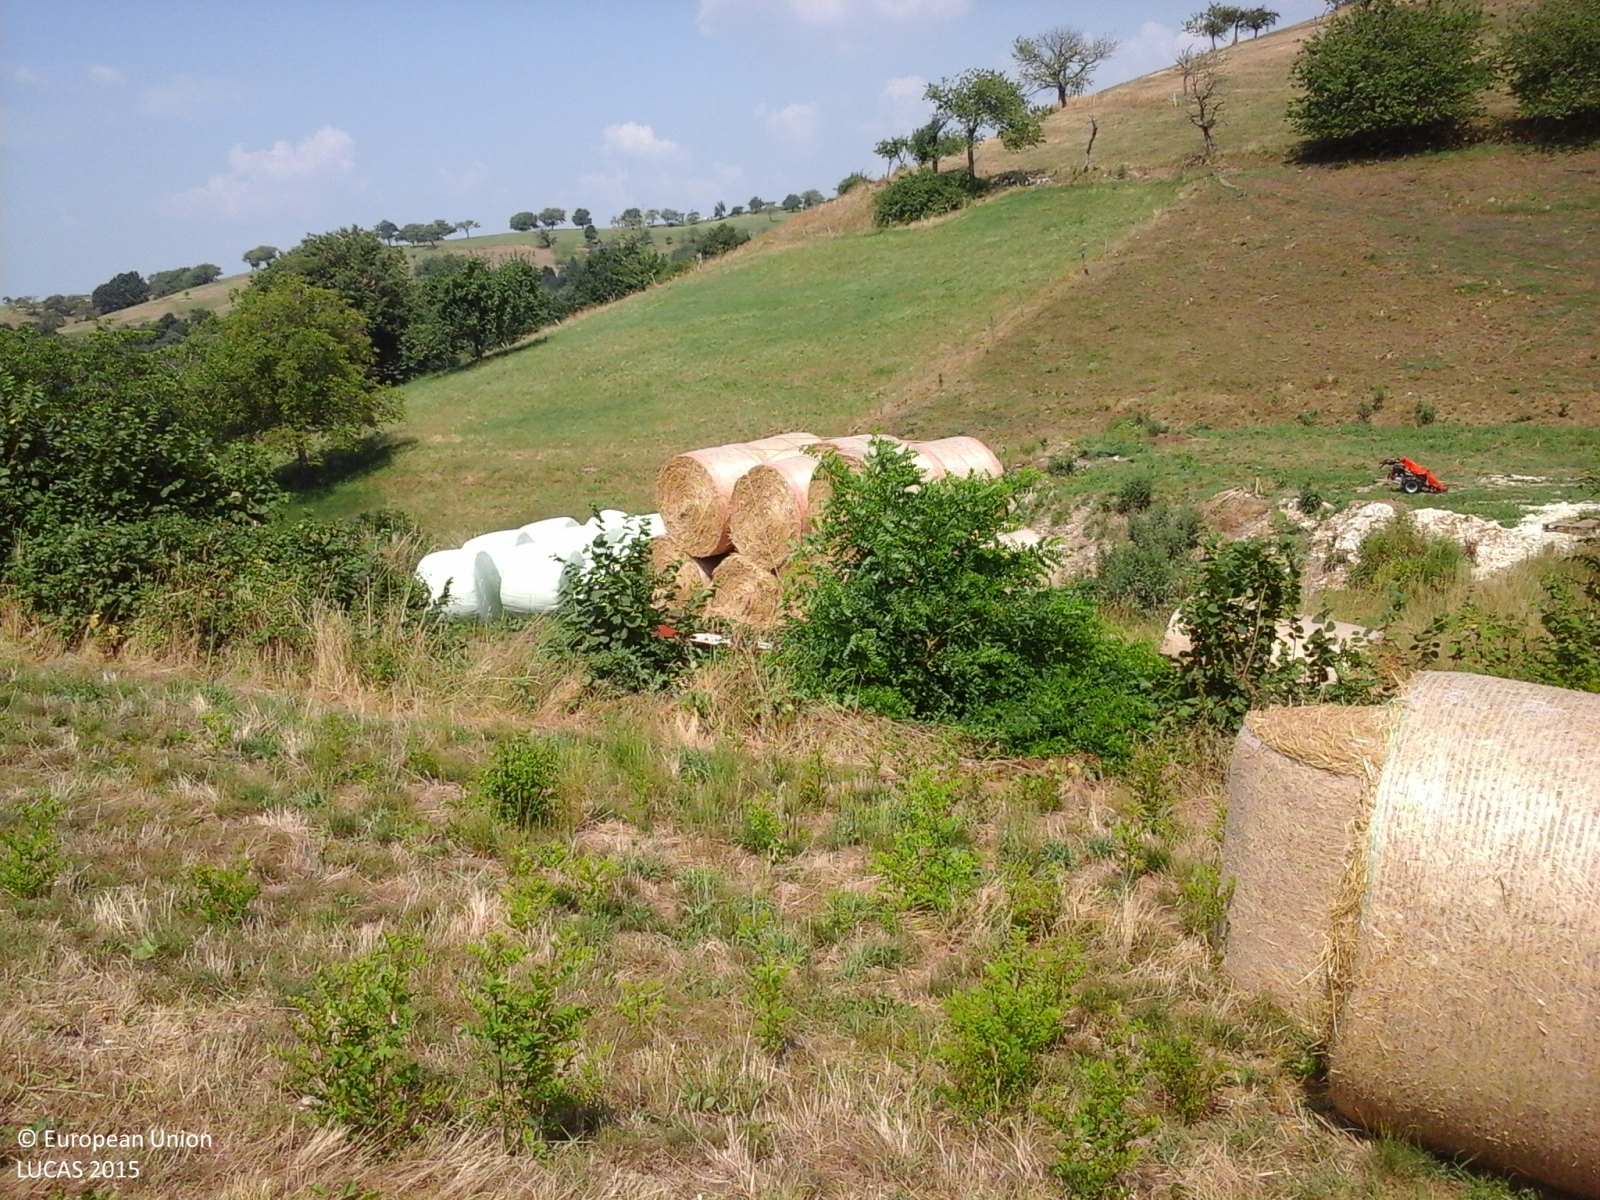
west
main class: Grassland
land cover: Grassland without tree/shrub cover
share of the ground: > 75 %
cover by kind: herbaceous plants 100 %
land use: Agriculture (excluding fallow land and kitchen gardens)
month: July
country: IT
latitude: 45.5706
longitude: 11.1129
